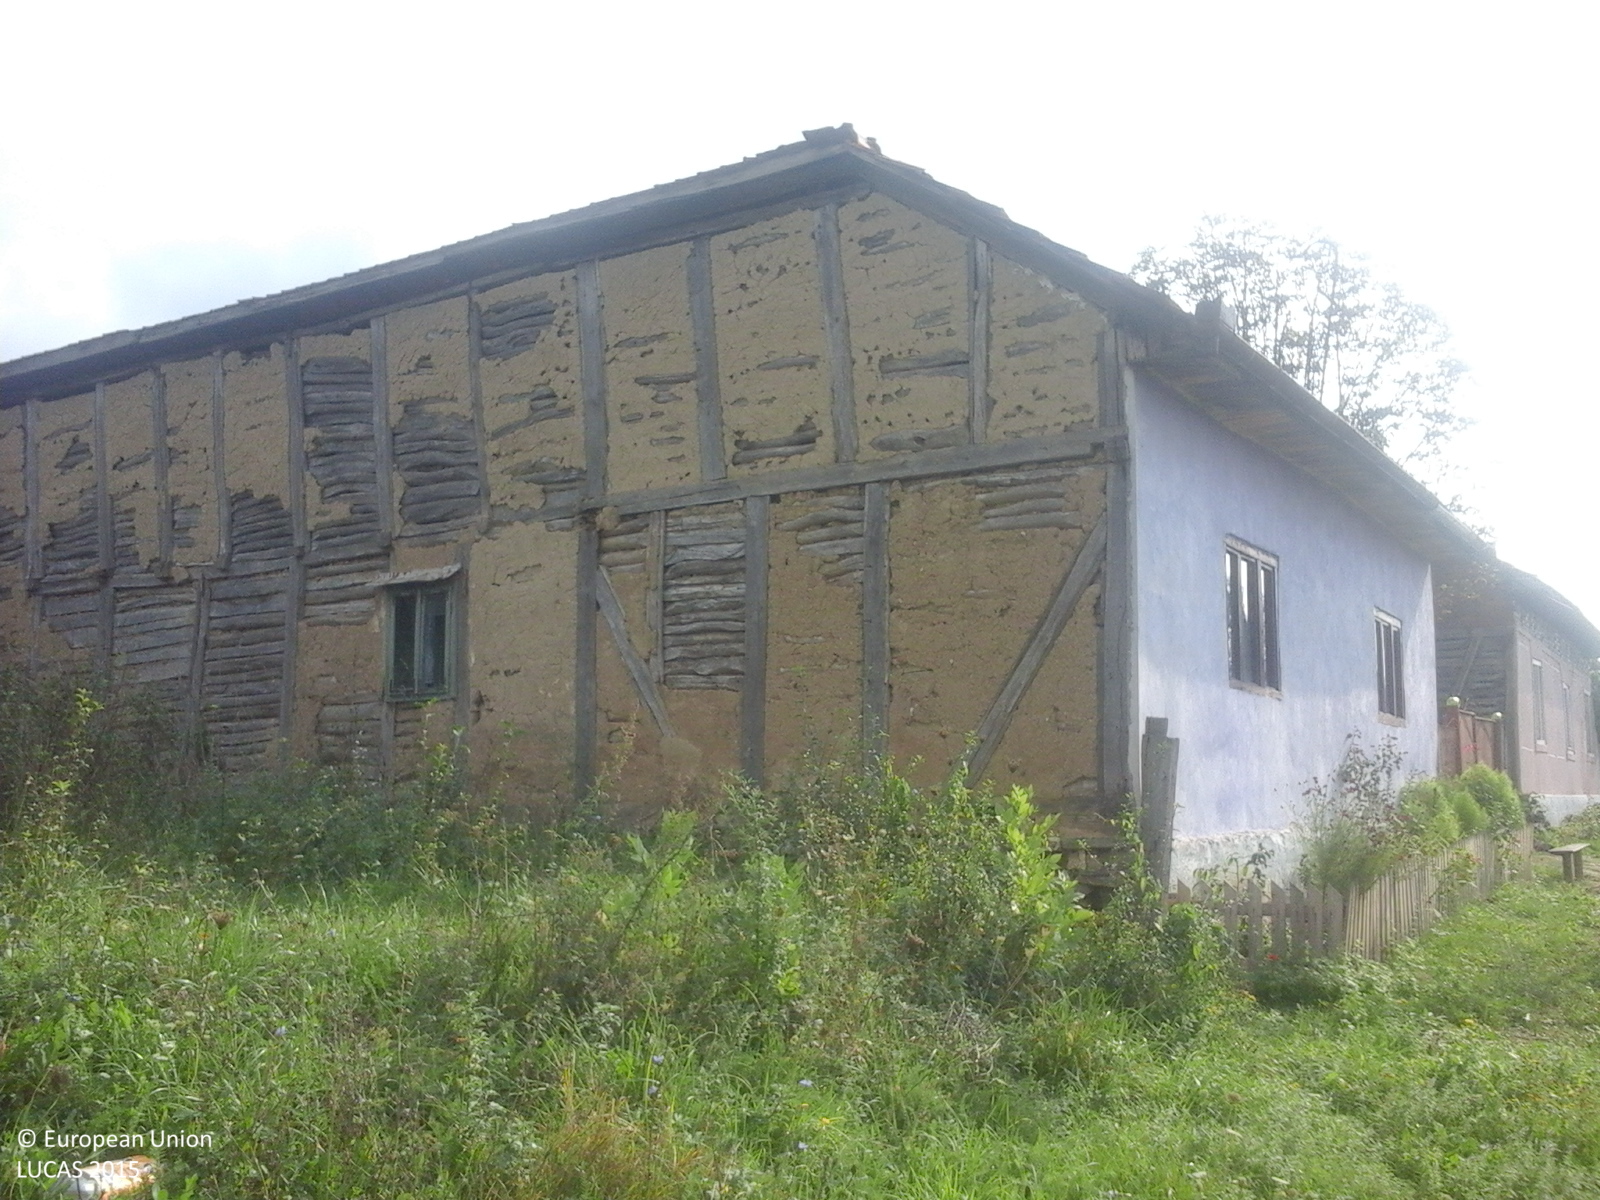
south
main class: Grassland
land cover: Grassland without tree/shrub cover
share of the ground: > 75 %
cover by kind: herbaceous plants 100 %
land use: Agriculture (excluding fallow land and kitchen gardens)
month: September
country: RO
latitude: 45.8546
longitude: 22.3184
